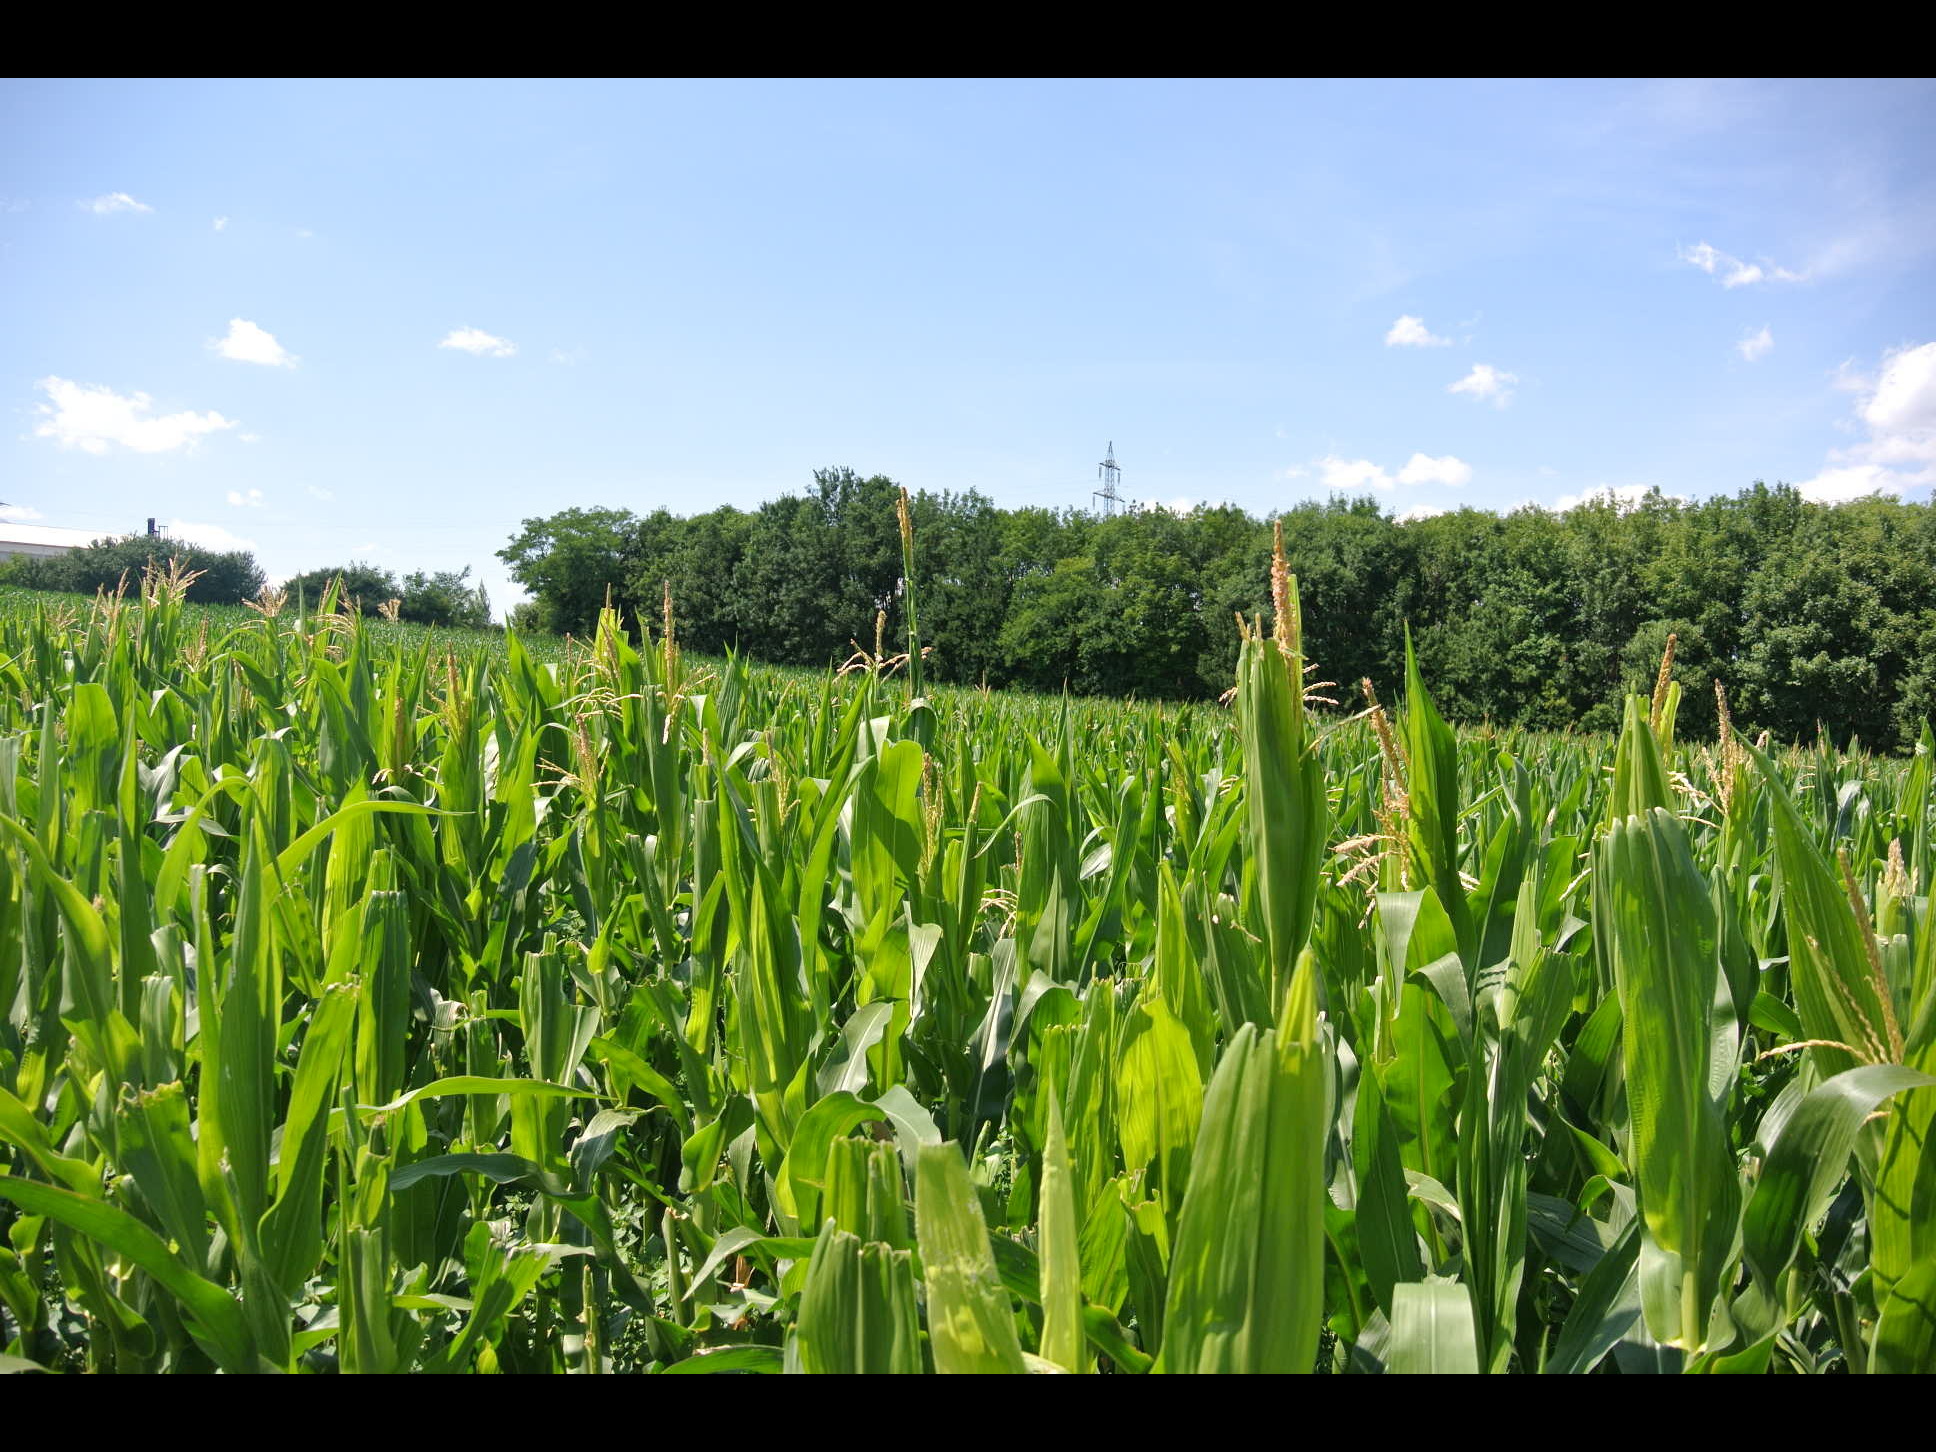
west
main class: Cropland
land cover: Maize
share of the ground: > 75 %
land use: Agriculture (excluding fallow land and kitchen gardens)
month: July
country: AT
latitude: 47.7296
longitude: 16.4174
